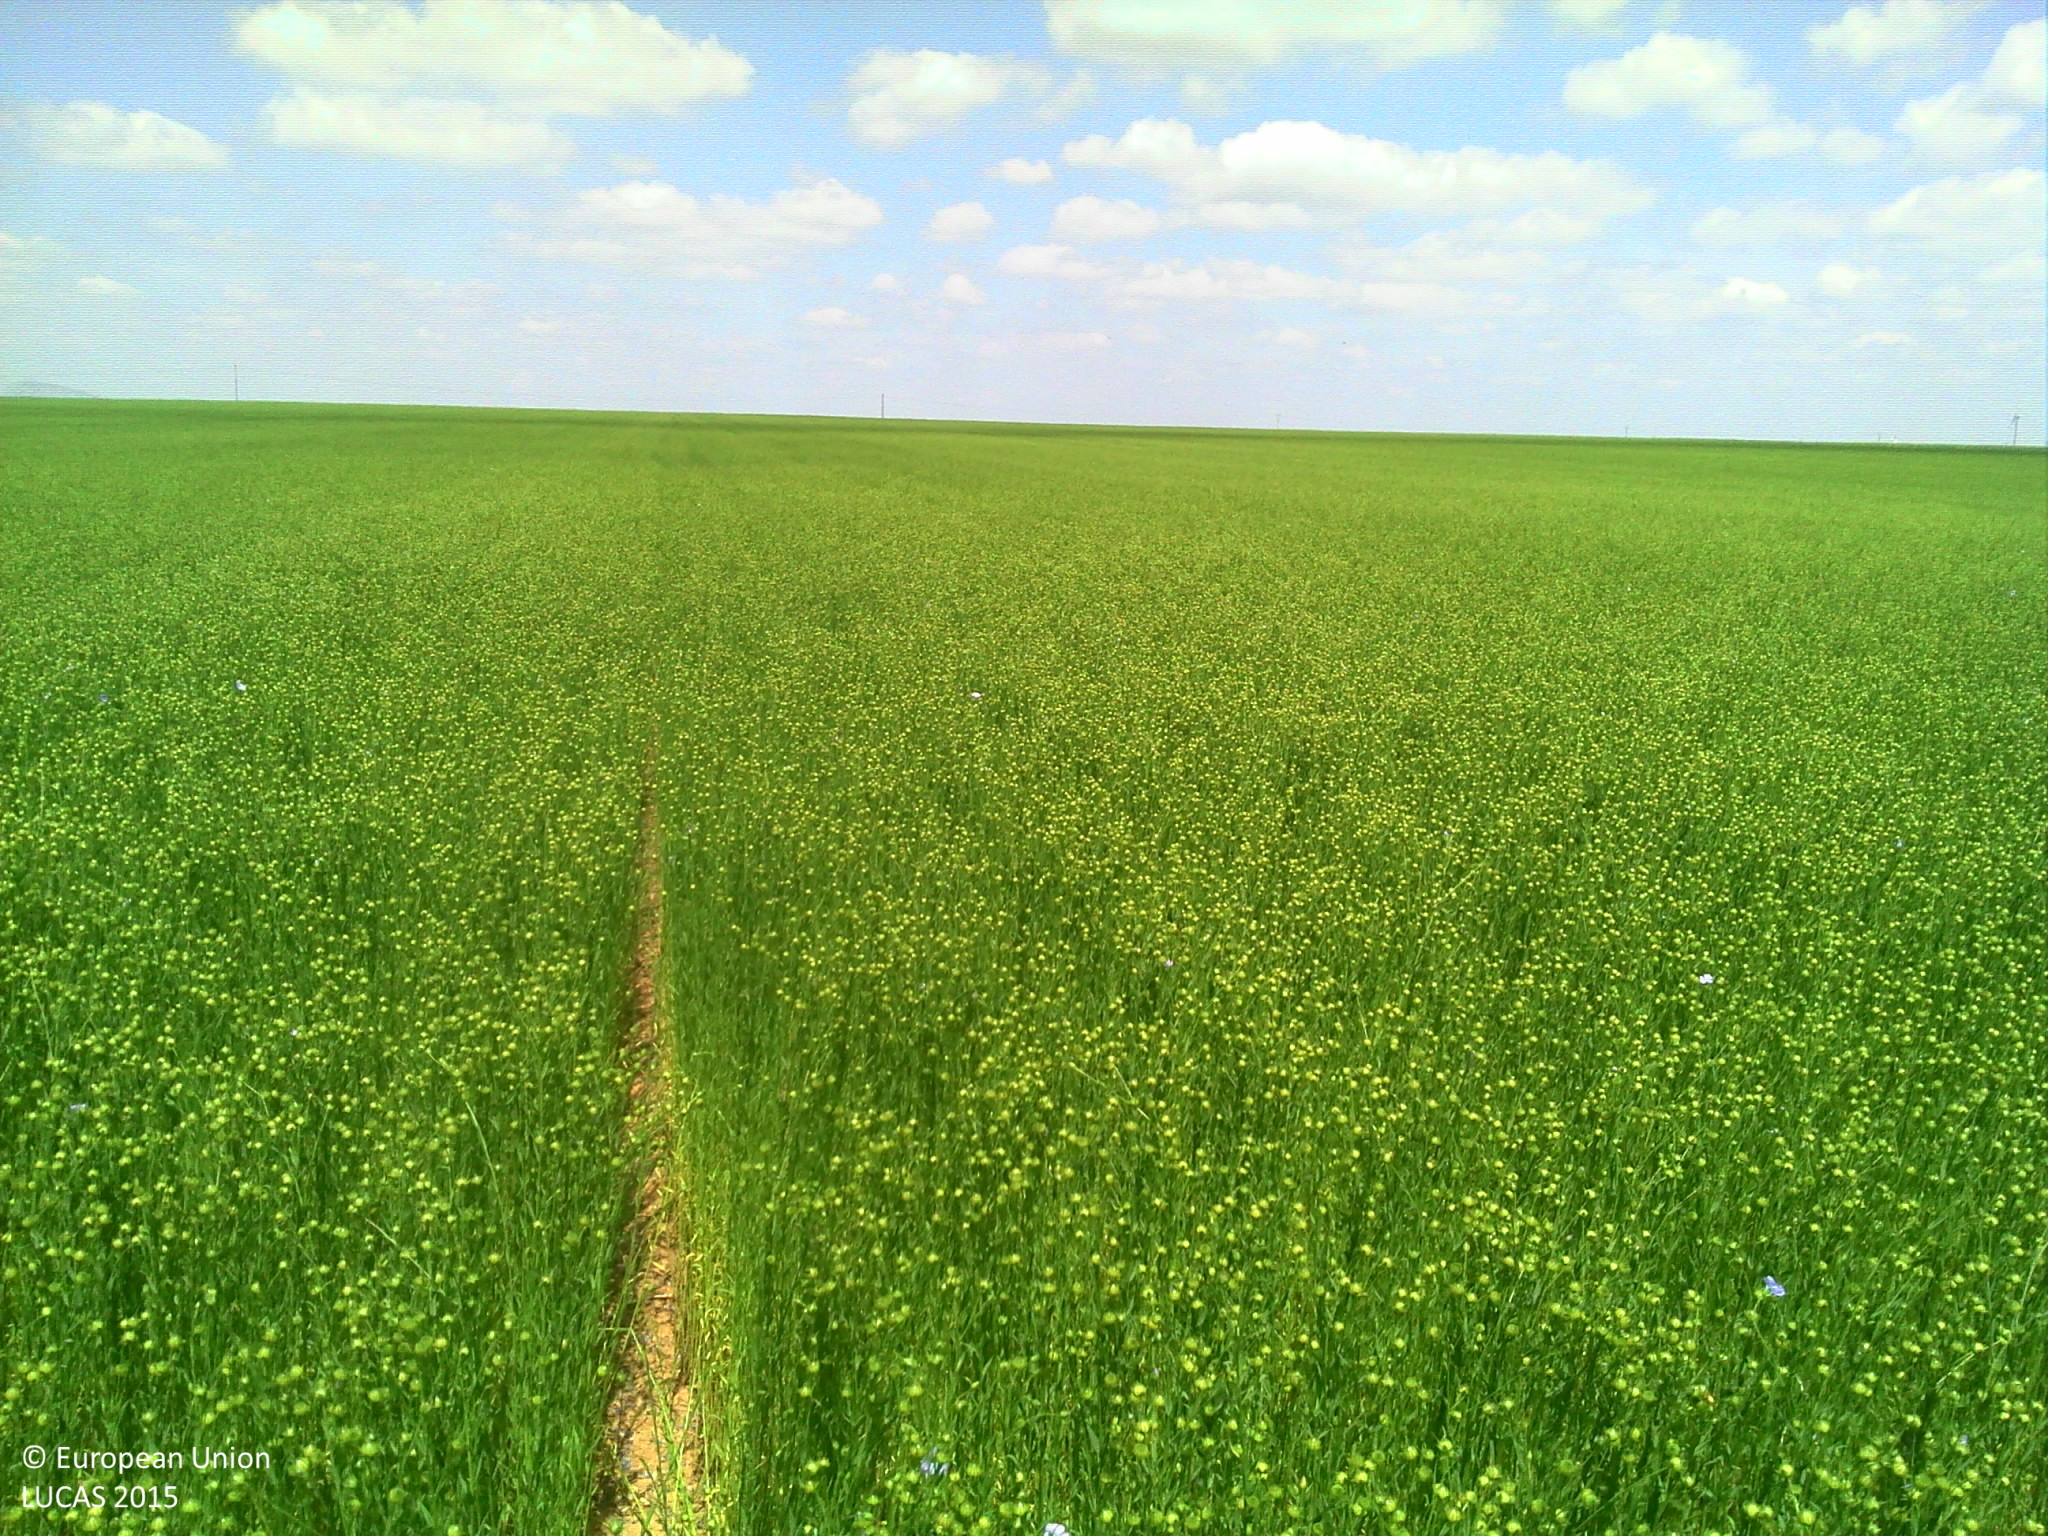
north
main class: Cropland
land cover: Other fibre and oleaginous crops
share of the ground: > 75 %
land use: Agriculture (excluding fallow land and kitchen gardens)
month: June
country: FR
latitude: 49.6835
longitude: 2.4895
